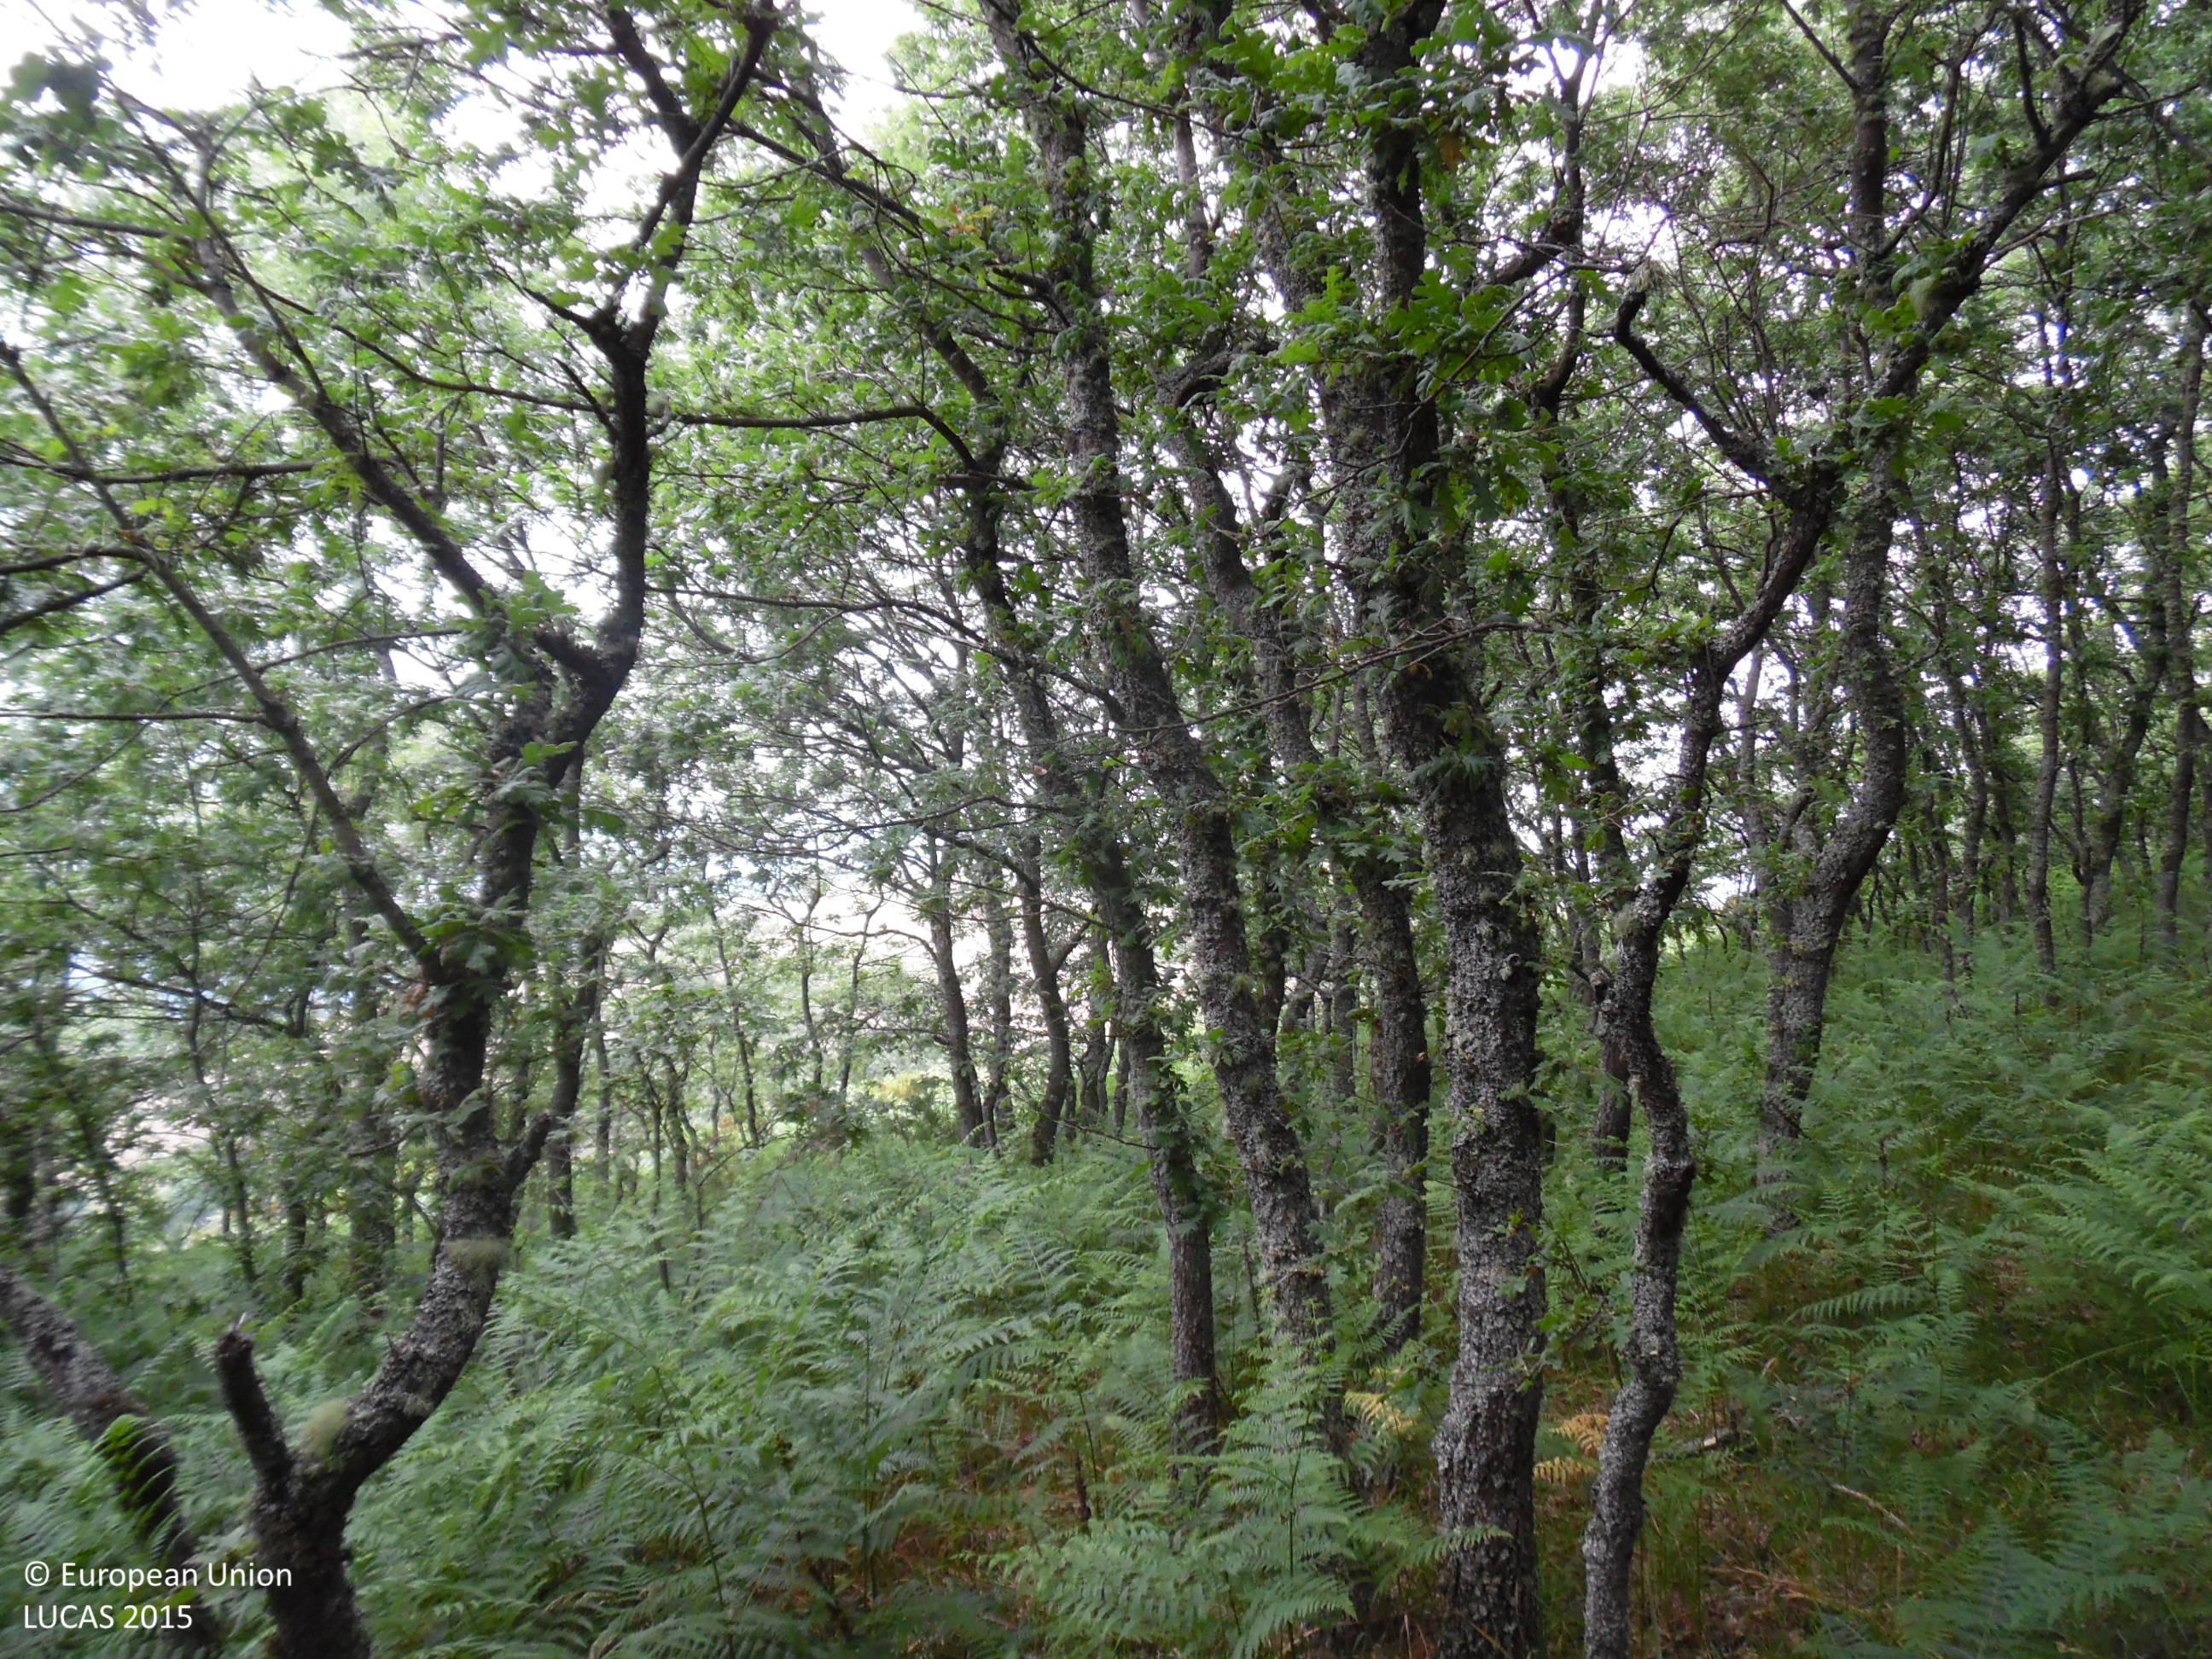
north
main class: Woodland
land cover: Broadleaved woodland
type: thermophilous deciduous forest
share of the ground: > 75 %
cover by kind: broadleaved forest trees 90 %, shrubs 5 %, consolidated bare surface 5 %
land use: Forestry
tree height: > 5 m
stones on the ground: < 10 %
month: July
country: ES
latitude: 43.1895
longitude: -6.5787
